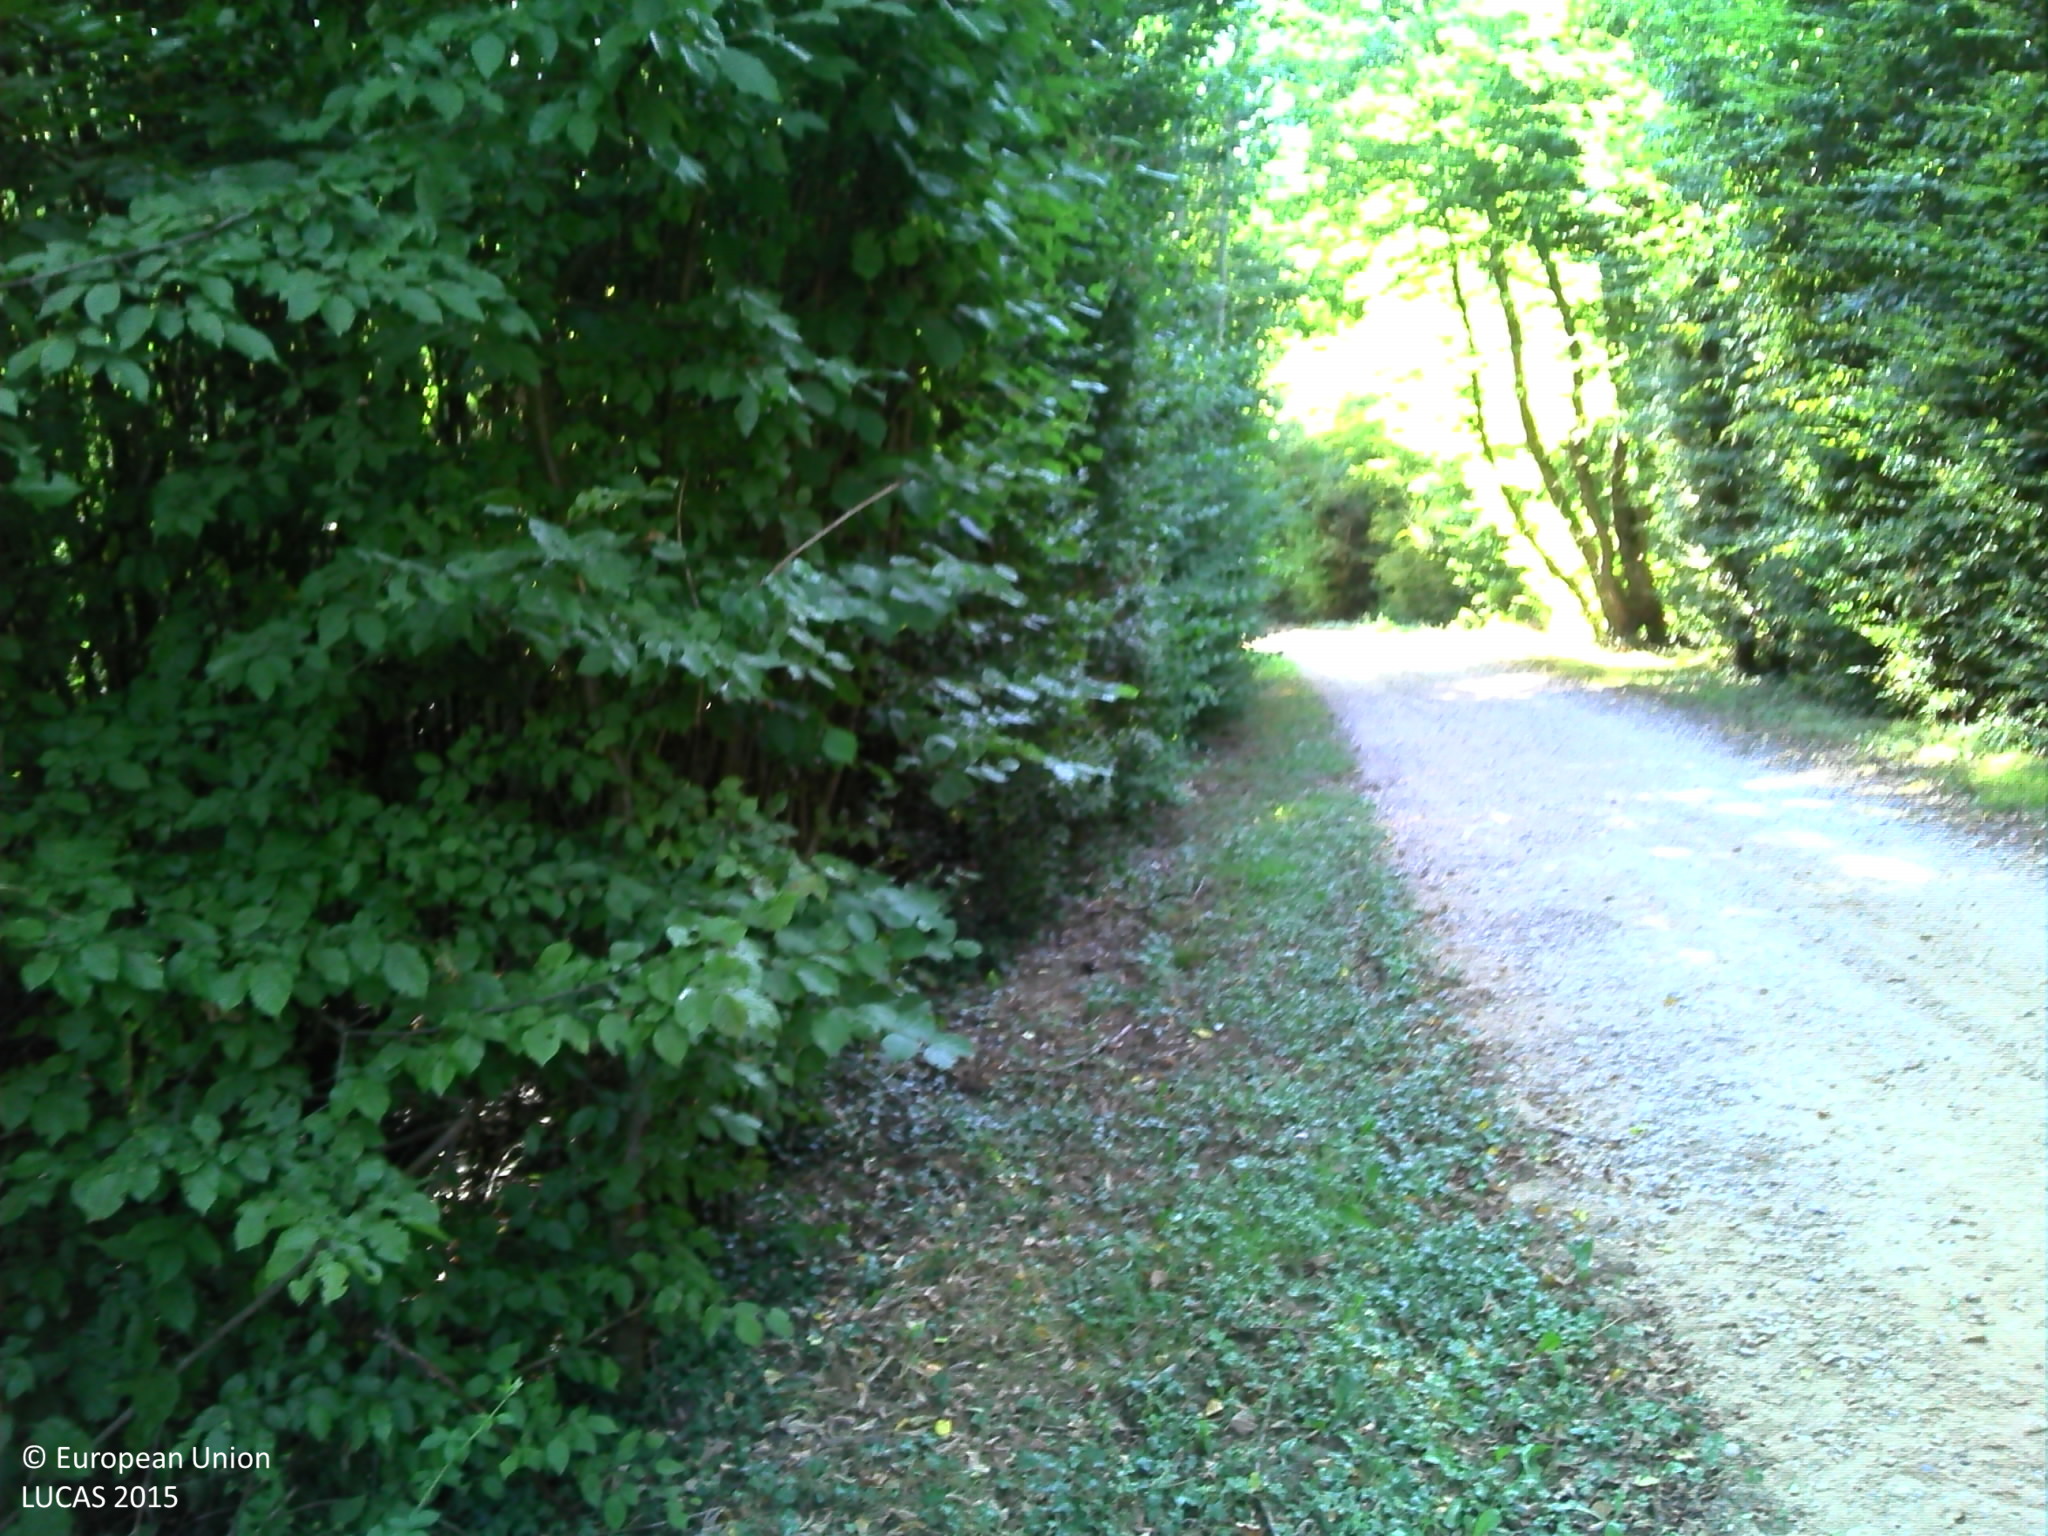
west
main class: Woodland
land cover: Broadleaved woodland
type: mesophytic deciduous forest
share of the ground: > 75 %
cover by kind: broadleaved forest trees 85 %, herbaceous plants 10 %, consolidated bare surface 5 %
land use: Forestry
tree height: > 5 m
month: August
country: FR
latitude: 45.7711
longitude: 5.1301
